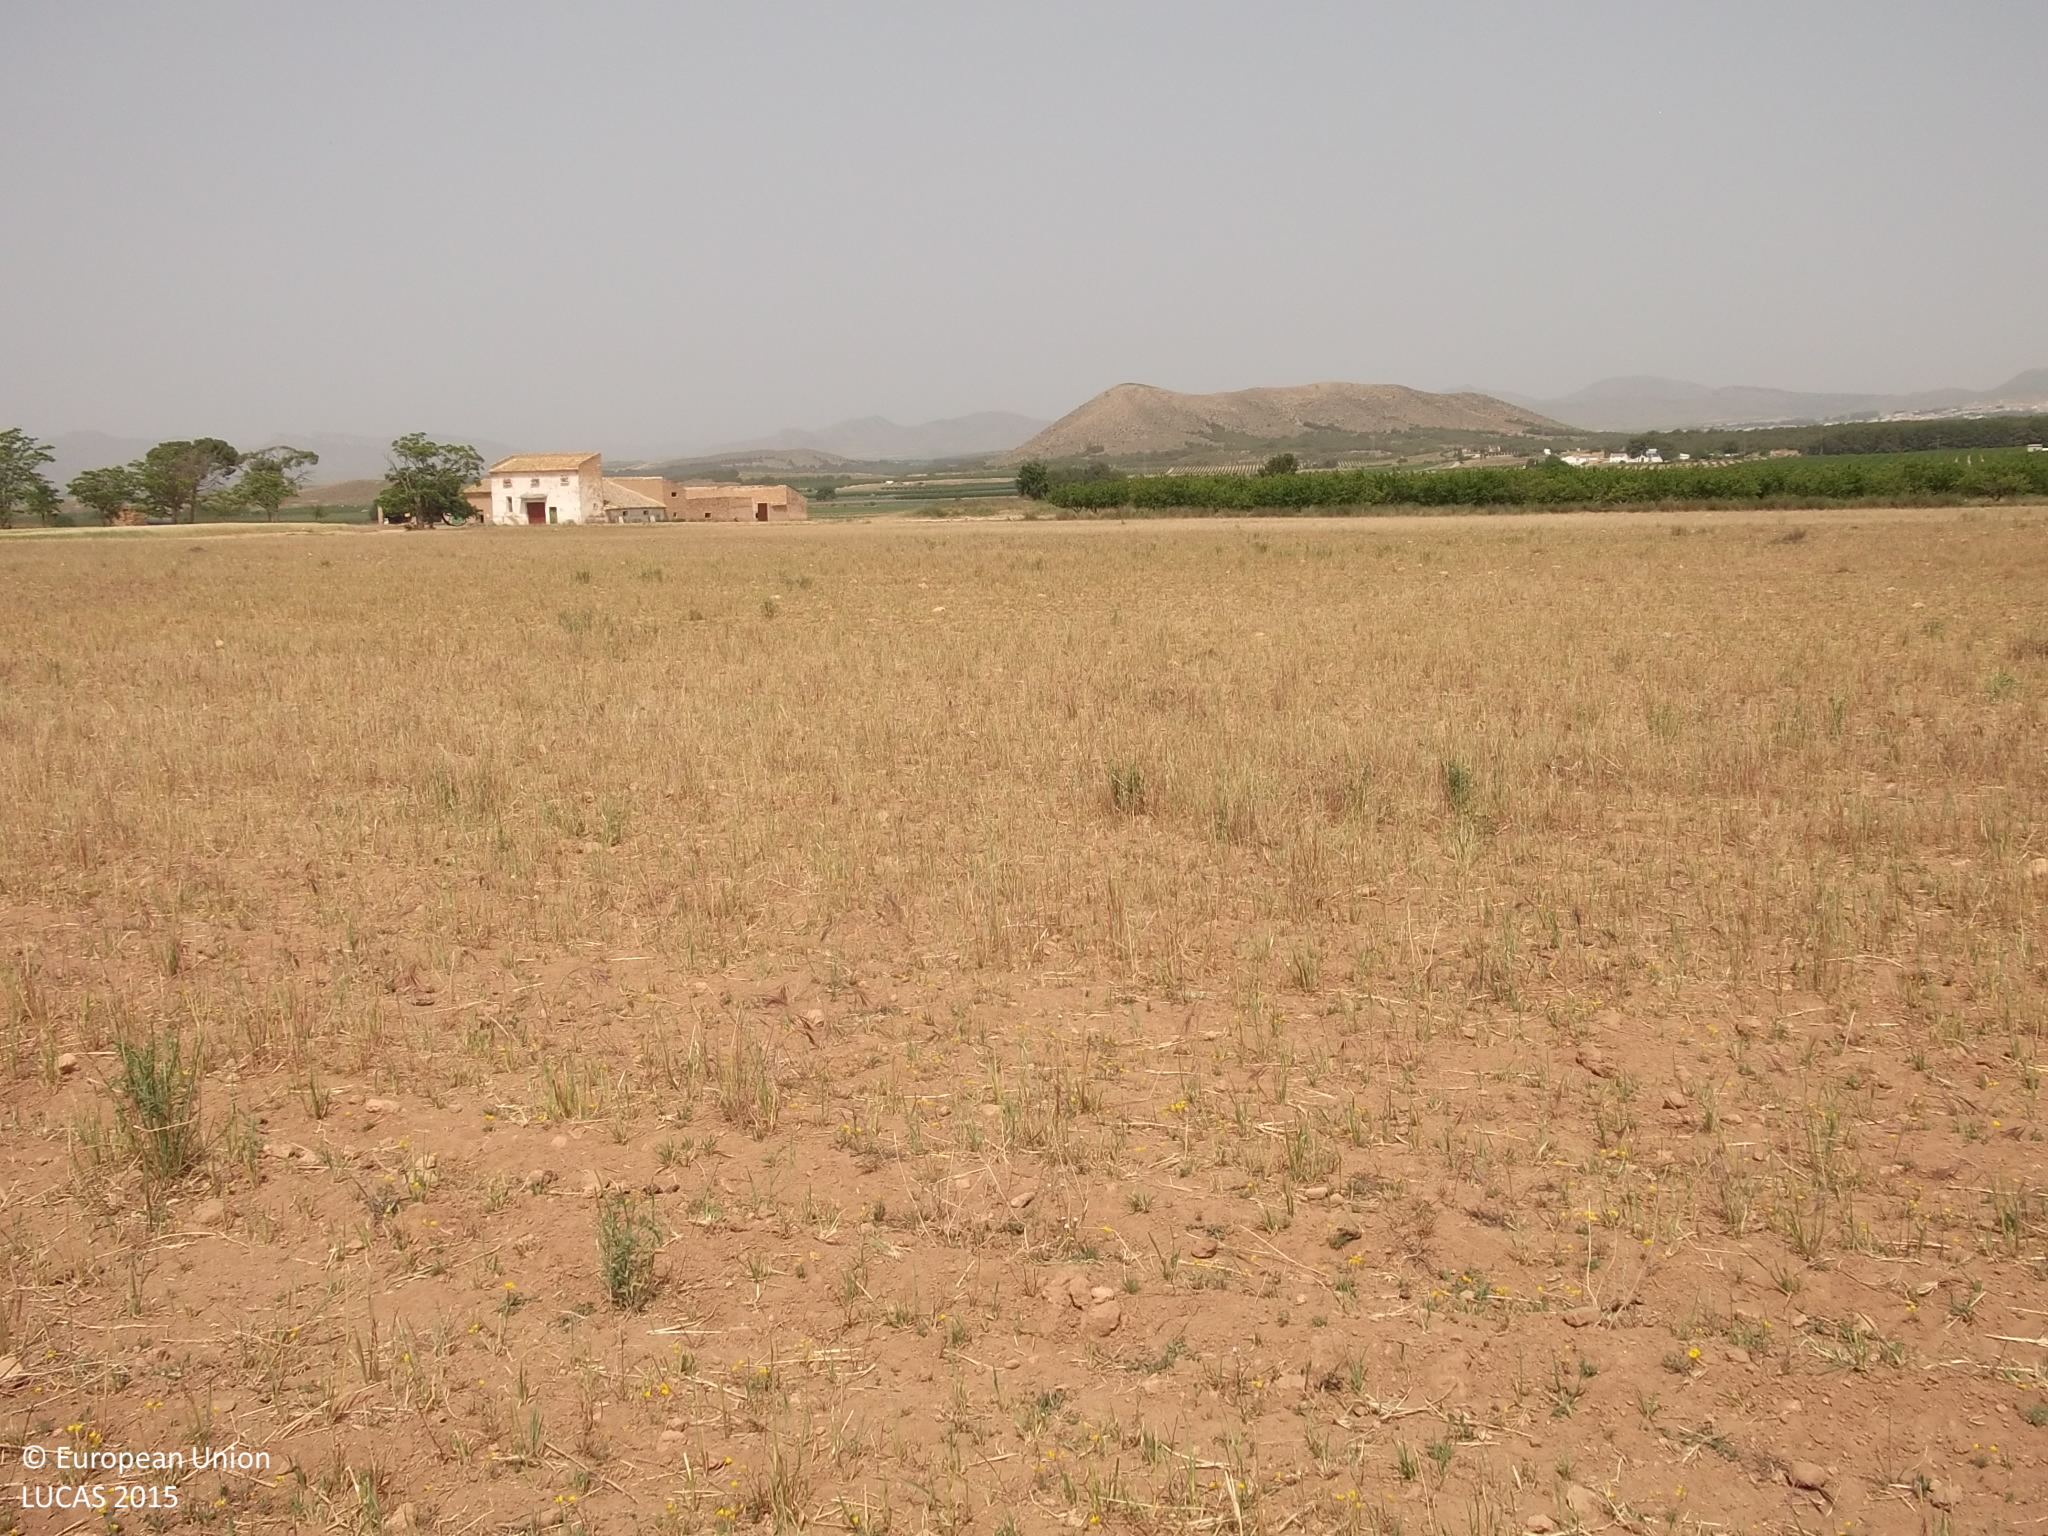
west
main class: Grassland
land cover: Spontaneously vegetated surfaces
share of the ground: 50 - 75 %
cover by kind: herbaceous plants 50 %, unconsolidated bare surface 50 %
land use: Fallow land
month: May
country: ES
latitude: 38.4564
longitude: -1.6466
